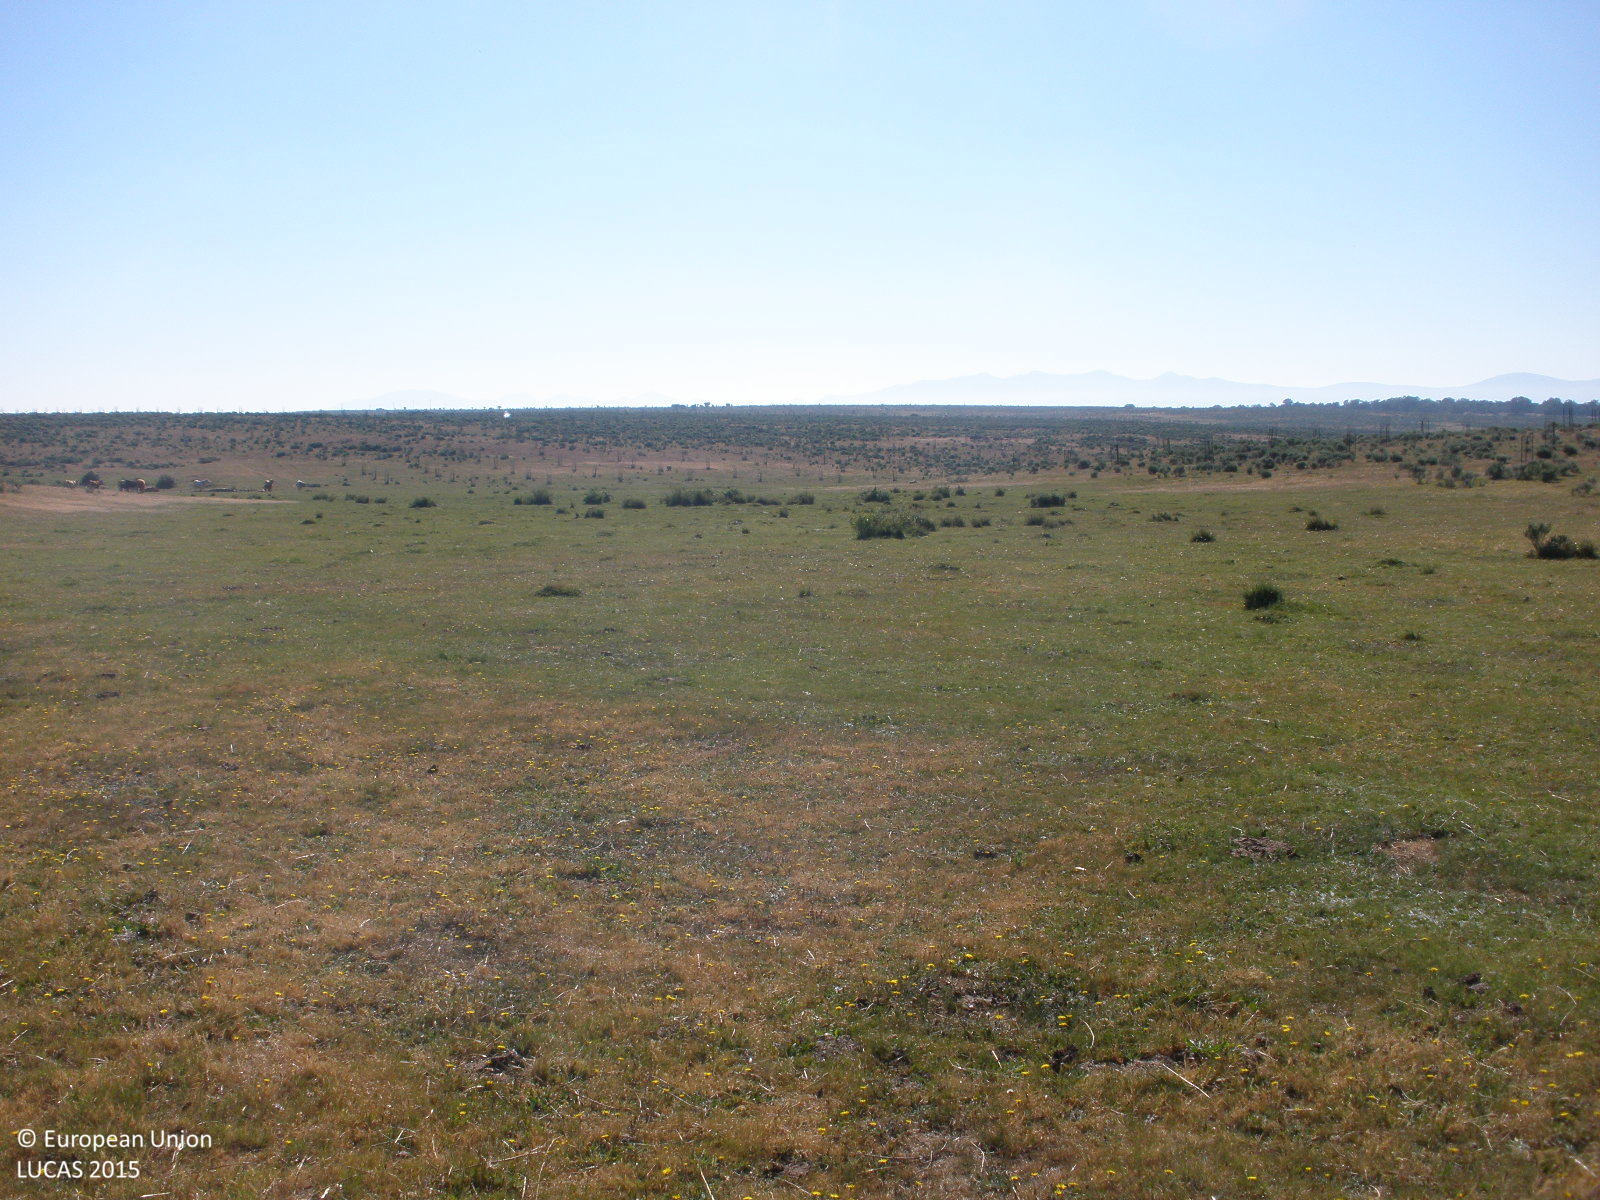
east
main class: Grassland
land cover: Grassland without tree/shrub cover
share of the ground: > 75 %
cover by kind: herbaceous plants 100 %
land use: Agriculture (excluding fallow land and kitchen gardens)
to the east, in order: Grassland without tree/shrub cover
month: June
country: ES
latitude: 40.4356
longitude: -6.6527
